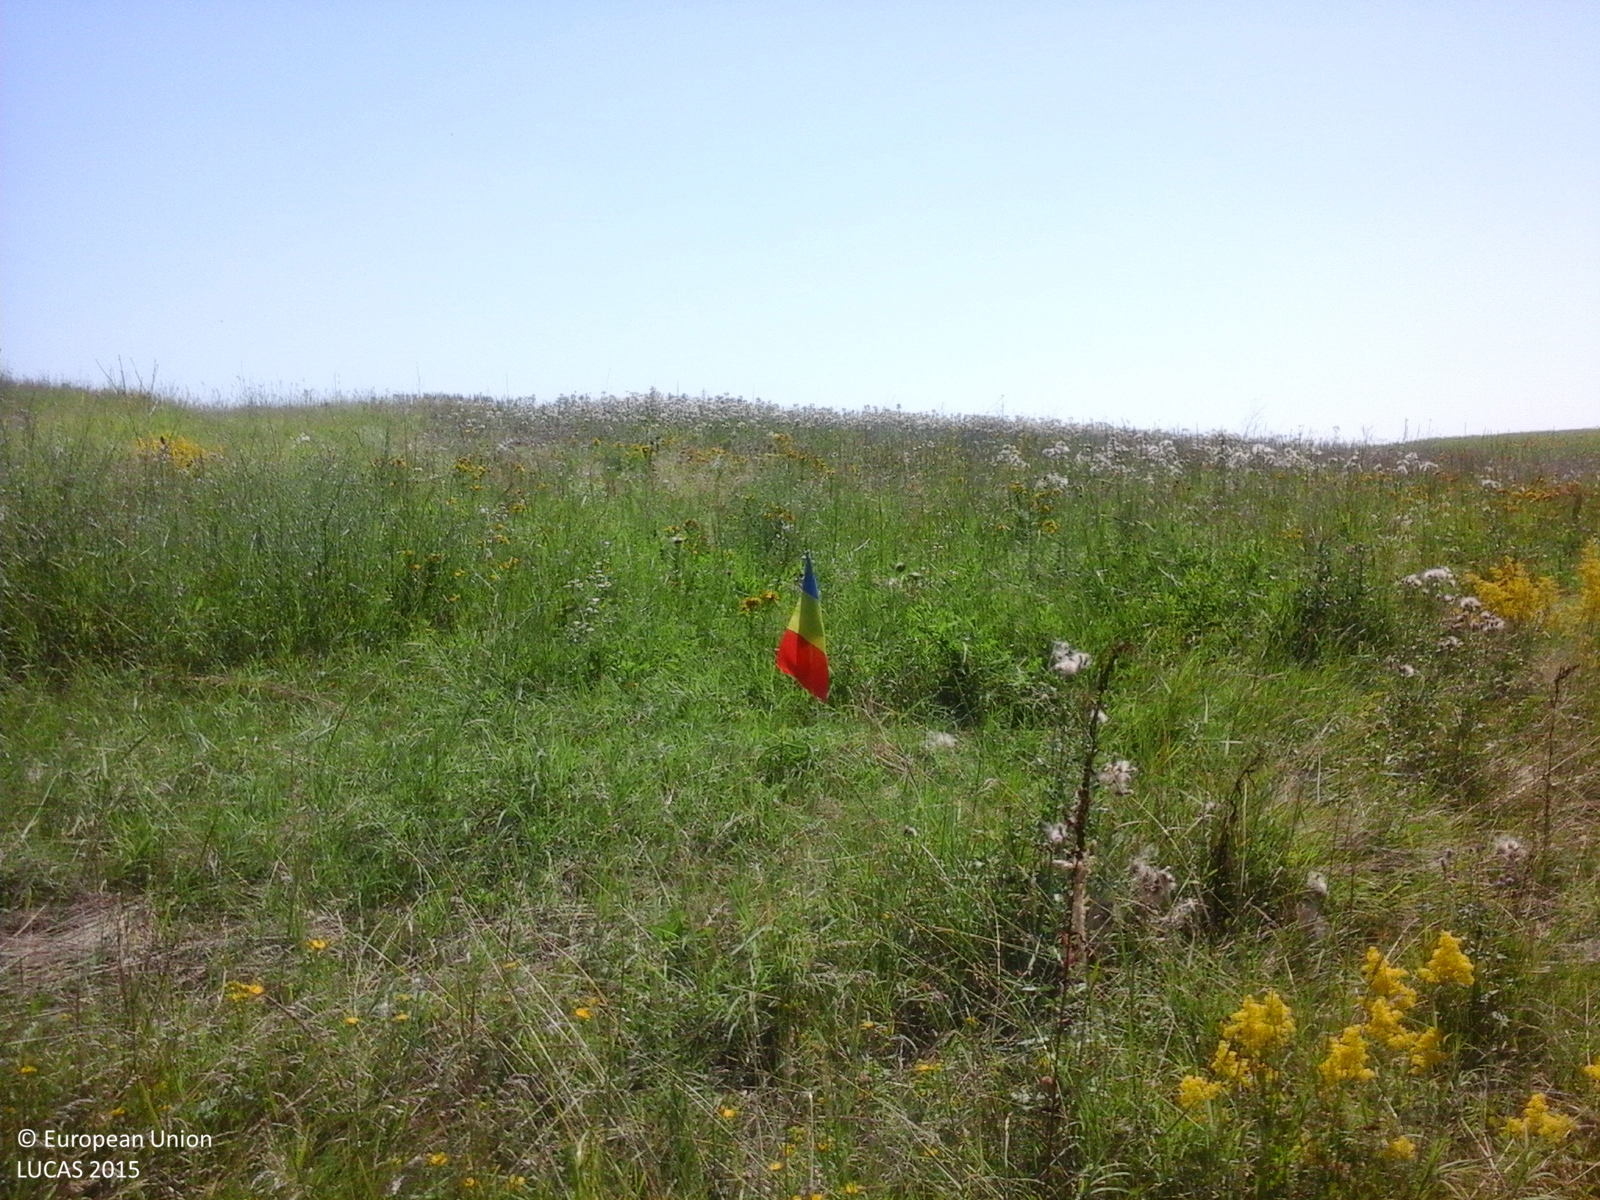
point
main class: Grassland
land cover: Spontaneously vegetated surfaces
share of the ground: > 75 %
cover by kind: herbaceous plants 100 %
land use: Fallow land
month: July
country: RO
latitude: 44.4058
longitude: 24.4979
